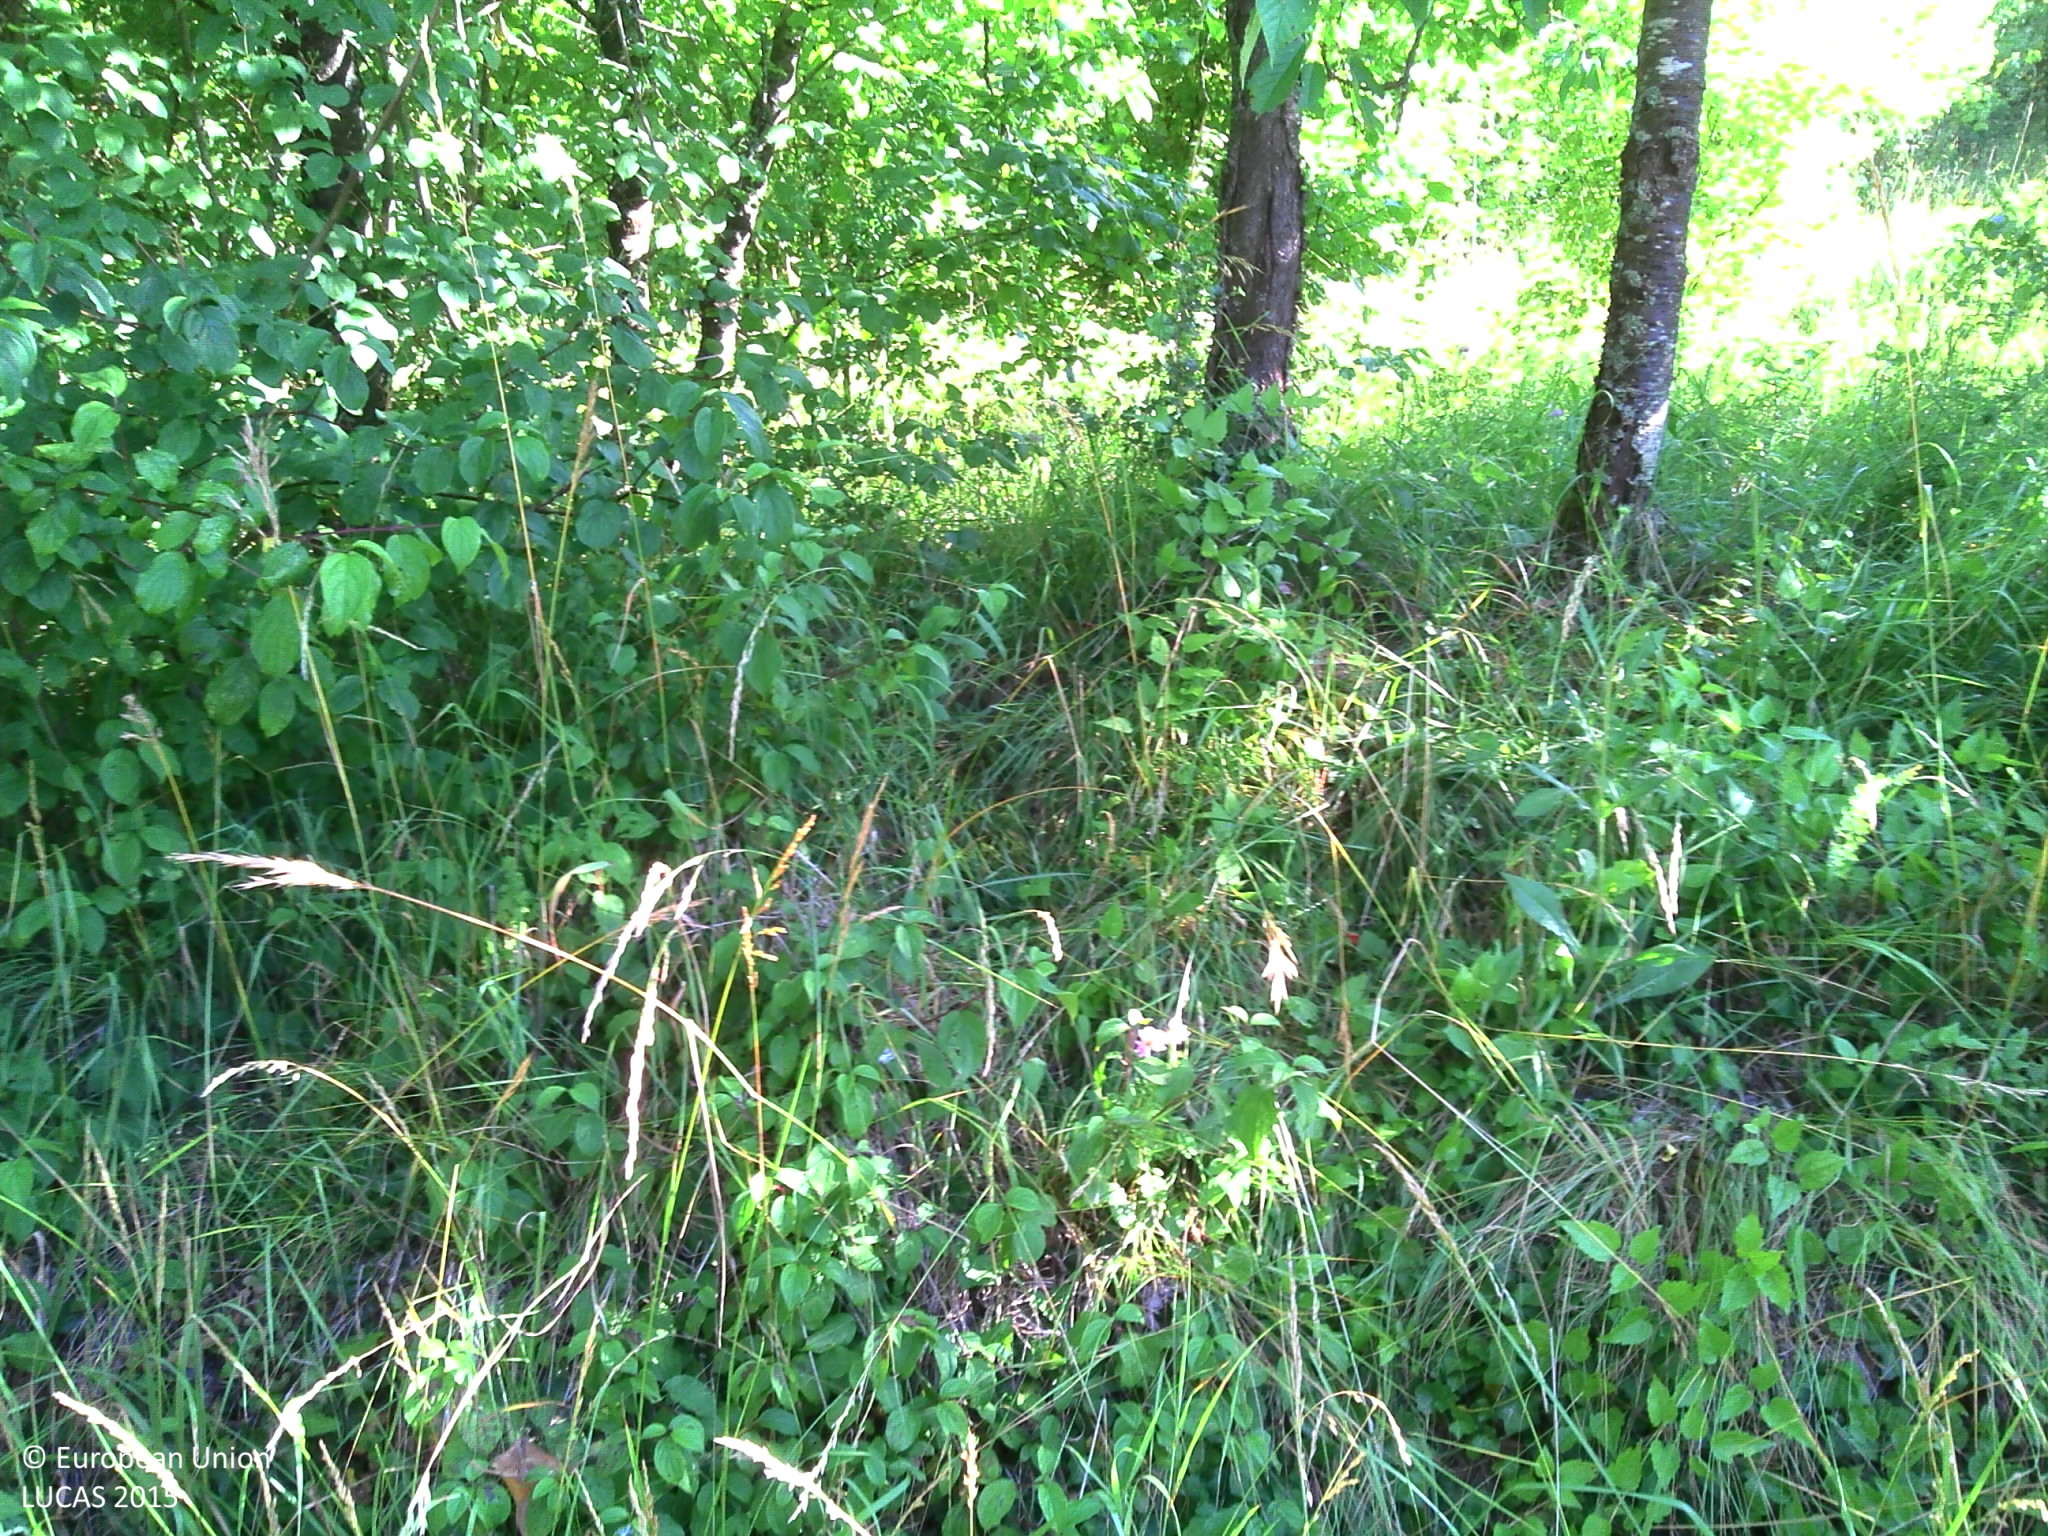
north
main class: Grassland
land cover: Grassland with sparse tree/shrub cover
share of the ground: > 75 %
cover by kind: herbaceous plants 95 %, broadleaved forest trees 5 %
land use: Residential
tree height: > 5 m
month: June
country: FR
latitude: 49.0154
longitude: 5.9933
